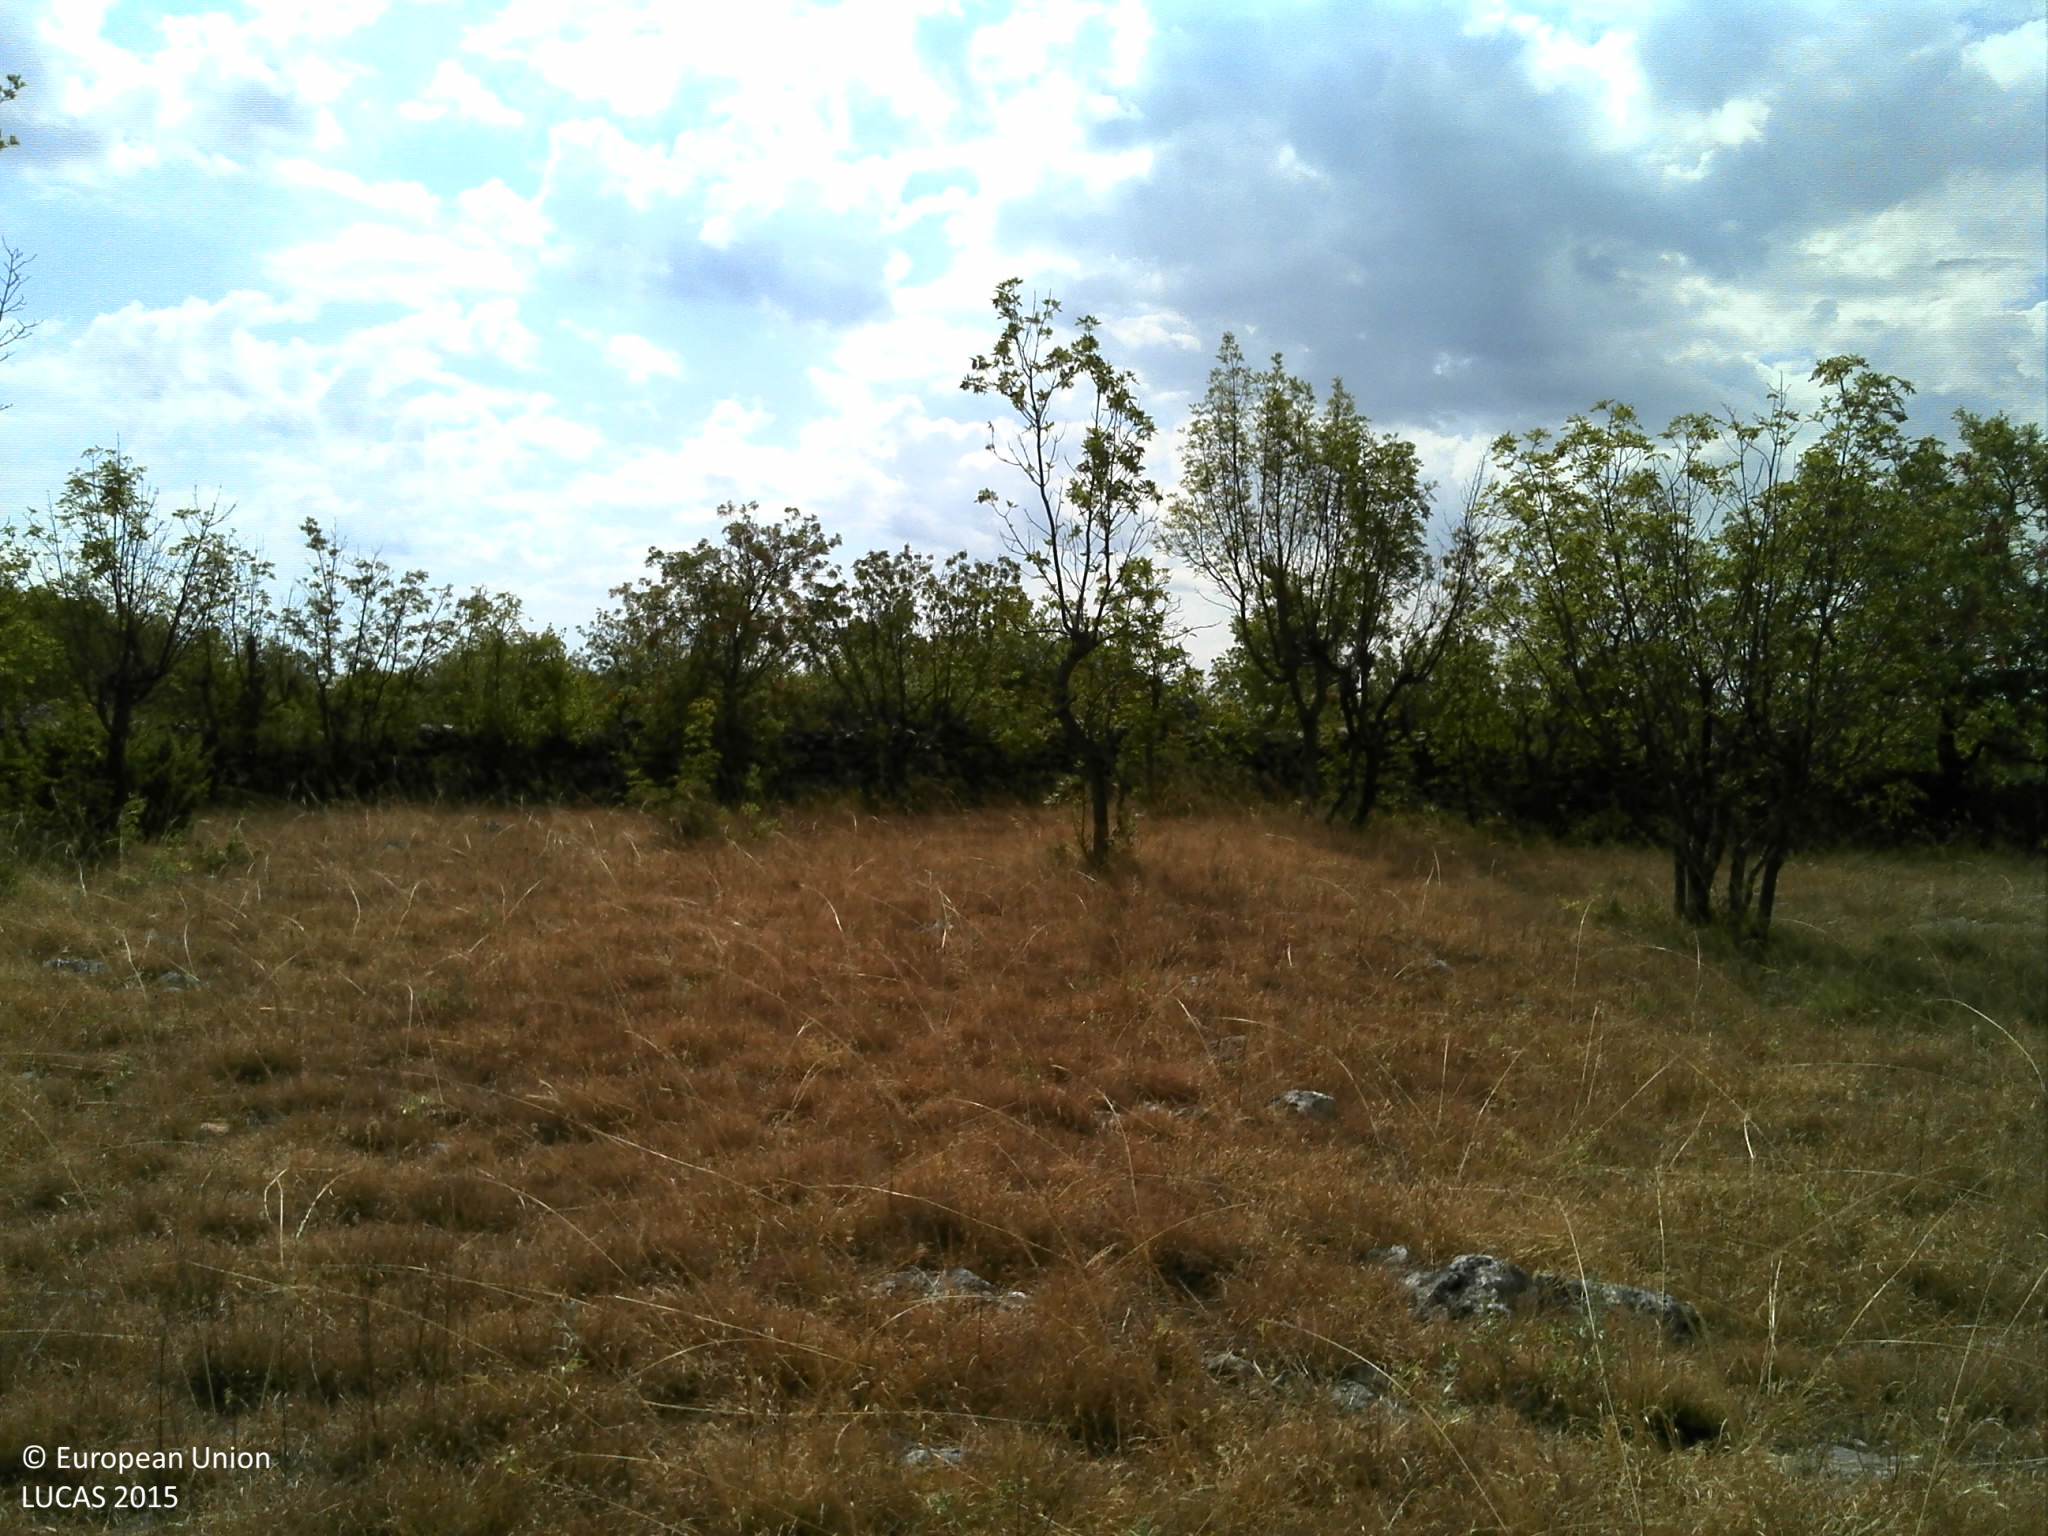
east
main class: Woodland
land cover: Broadleaved woodland
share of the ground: 10 - 25 %
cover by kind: herbaceous plants 70 %, broadleaved forest trees 15 %, shrubs 5 %, consolidated bare surface 5 %, unconsolidated bare surface 5 %
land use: Semi-natural and natural areas not in use
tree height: < 5 m
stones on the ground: < 10 %
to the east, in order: Broadleaved woodland; Dry stone walls; Broadleaved woodland; Dry stone walls; Shrubland with sparse tree cover; Dry stone walls; Grassland with sparse tree/shrub cover; Dry stone walls; Shrubland with sparse tree cover; Dry stone walls; Shrubland with sparse tree cover; Dry stone walls; Broadleaved woodland
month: July
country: HR
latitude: 43.7542
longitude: 16.1143
